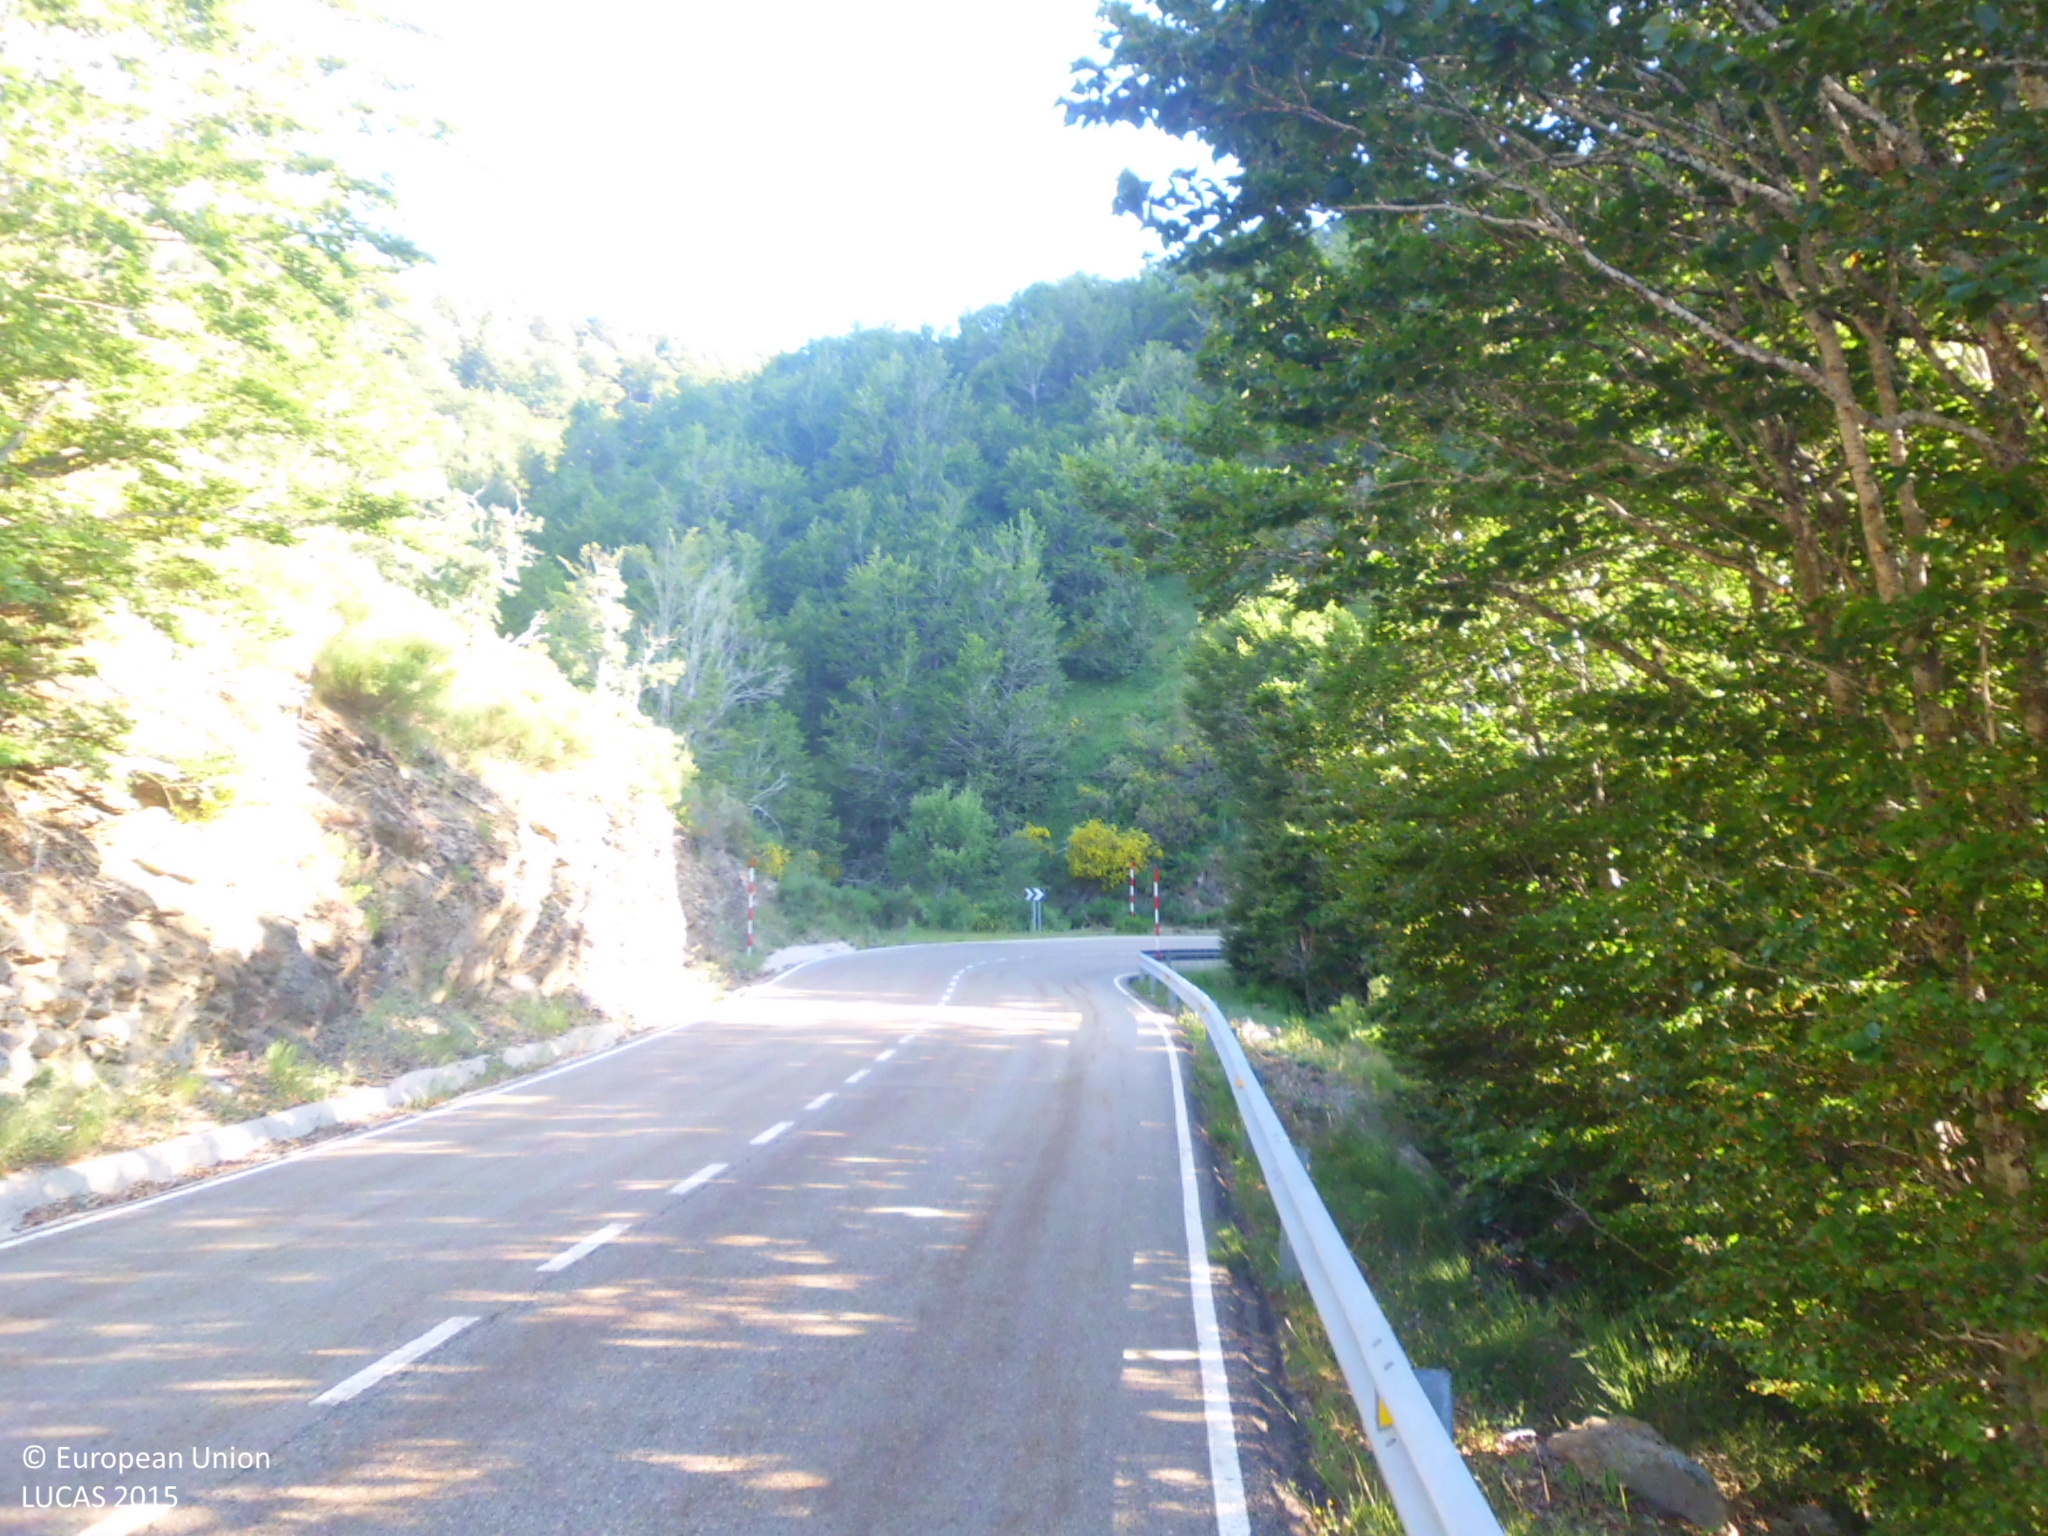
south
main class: Woodland
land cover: Broadleaved woodland
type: acidophilous oak and oak-birch forest
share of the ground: > 75 %
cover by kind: broadleaved forest trees 95 %, herbaceous plants 5 %
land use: Semi-natural and natural areas not in use
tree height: > 5 m
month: June
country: ES
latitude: 42.9303
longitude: -4.9514
